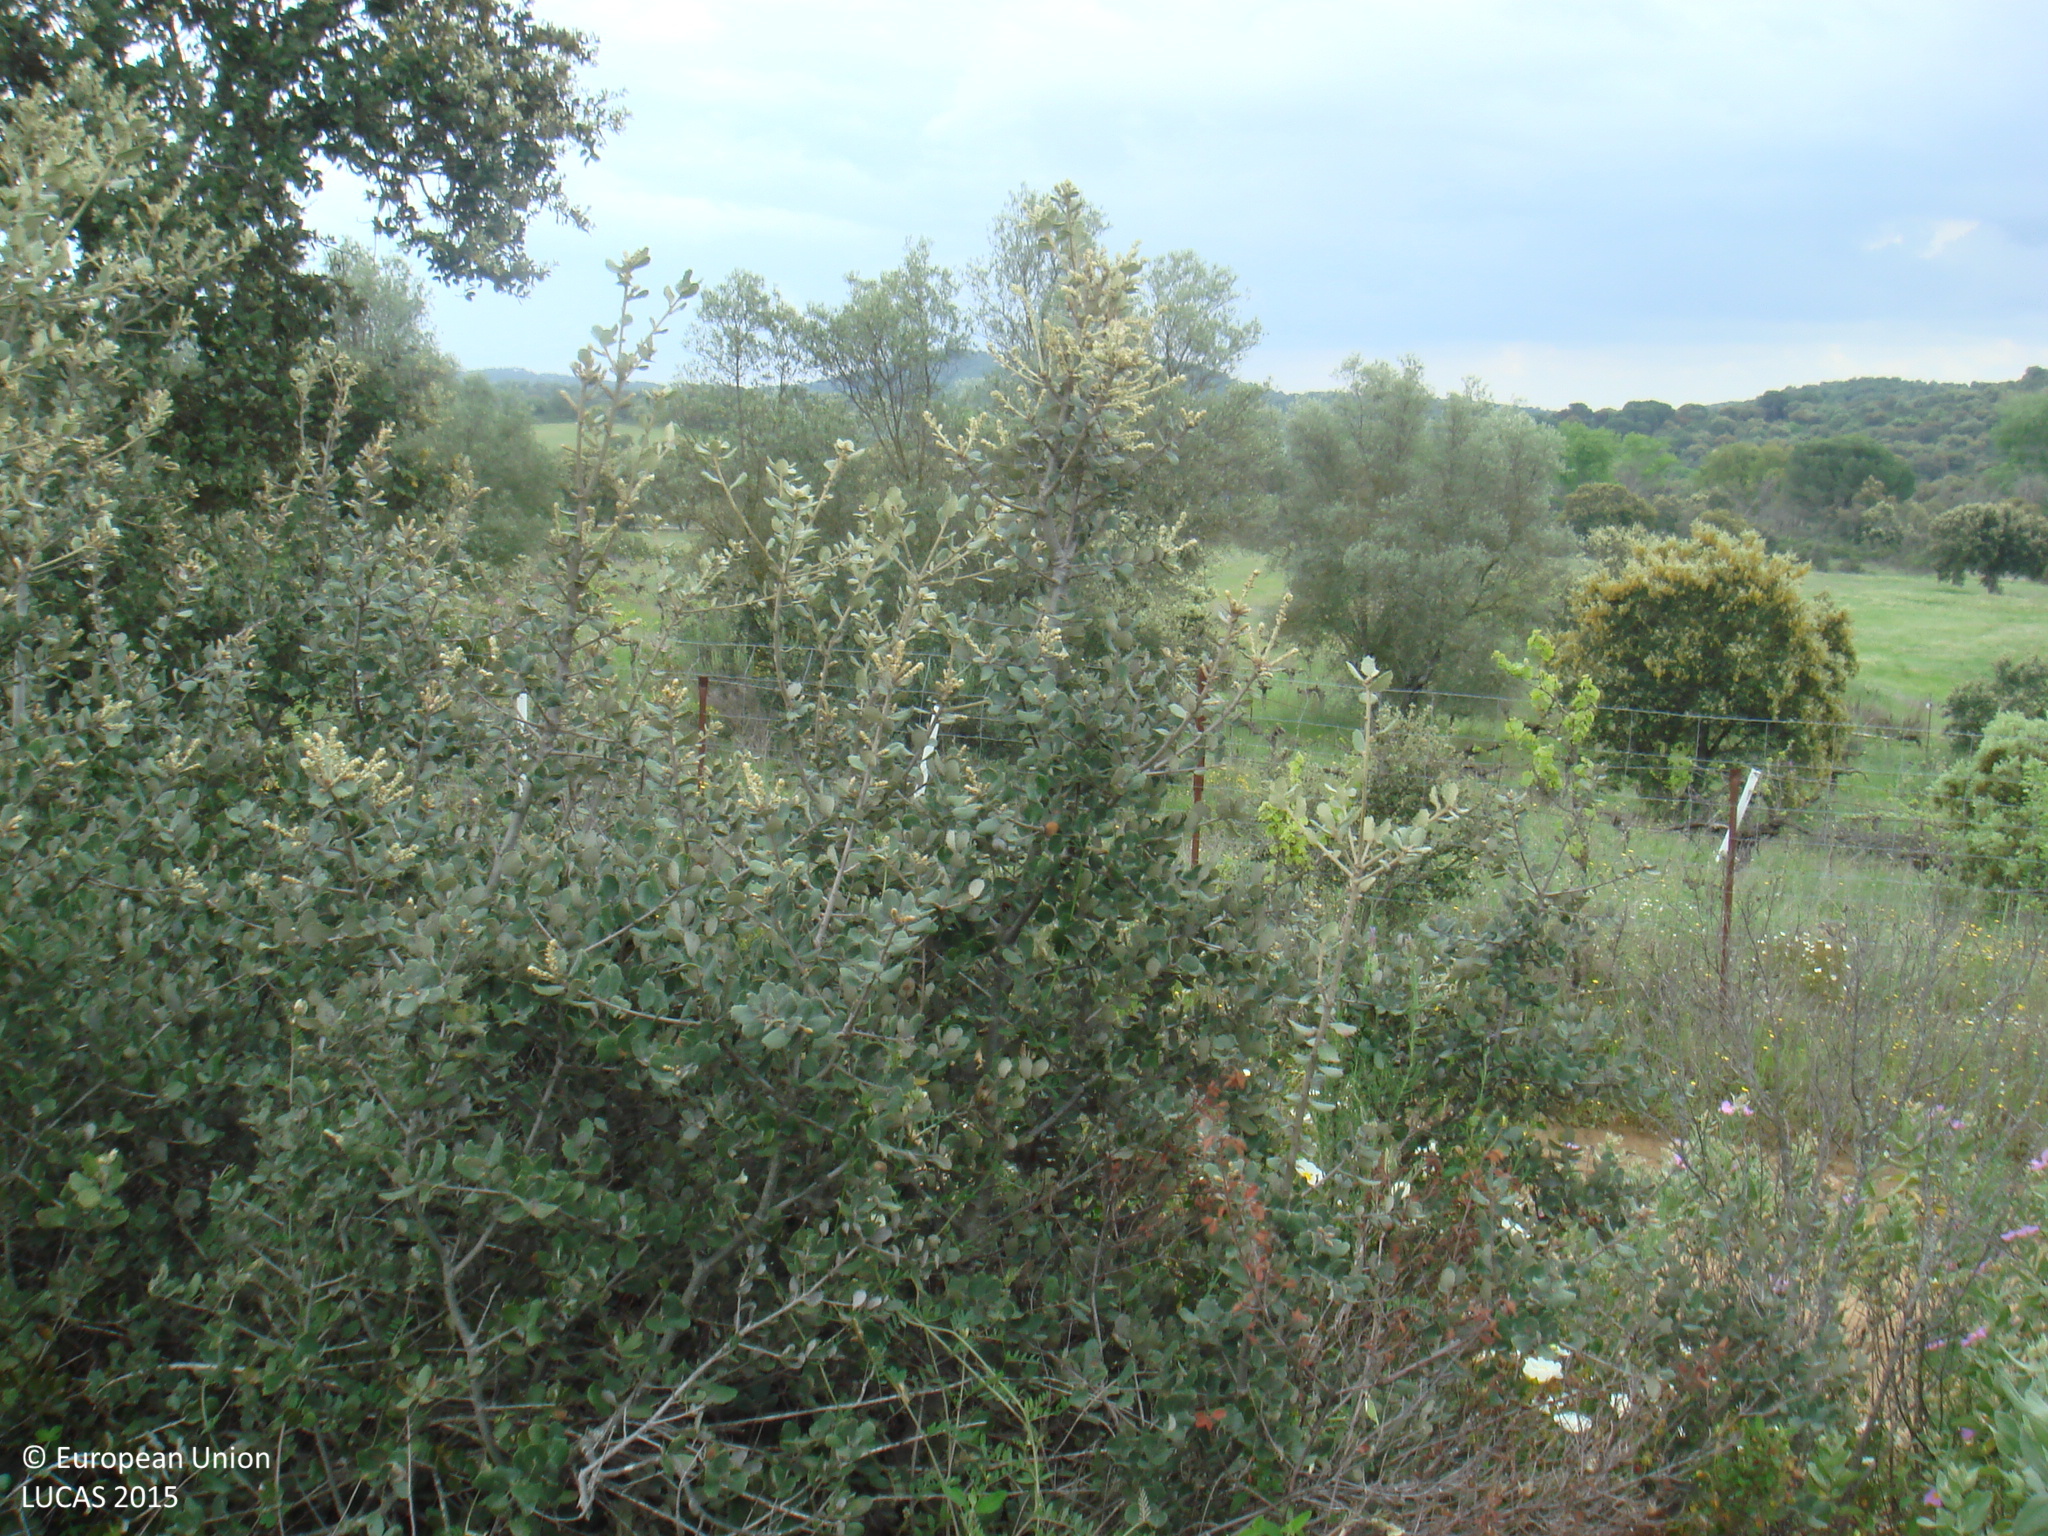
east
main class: Shrubland
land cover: Shrubland with sparse tree cover
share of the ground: > 75 %
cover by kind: shrubs 55 %, herbaceous plants 40 %, broadleaved forest trees 5 %
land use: Semi-natural and natural areas not in use
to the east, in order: Shrubland with sparse tree cover; Tracks; Fences; Grassland with sparse tree/shrub cover; Vineyards; Grassland without tree/shrub cover; Other bare soil; Fences; Groves; Oats; Grassland with sparse tree/shrub cover
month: April
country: ES
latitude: 38.0332
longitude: -5.0481
